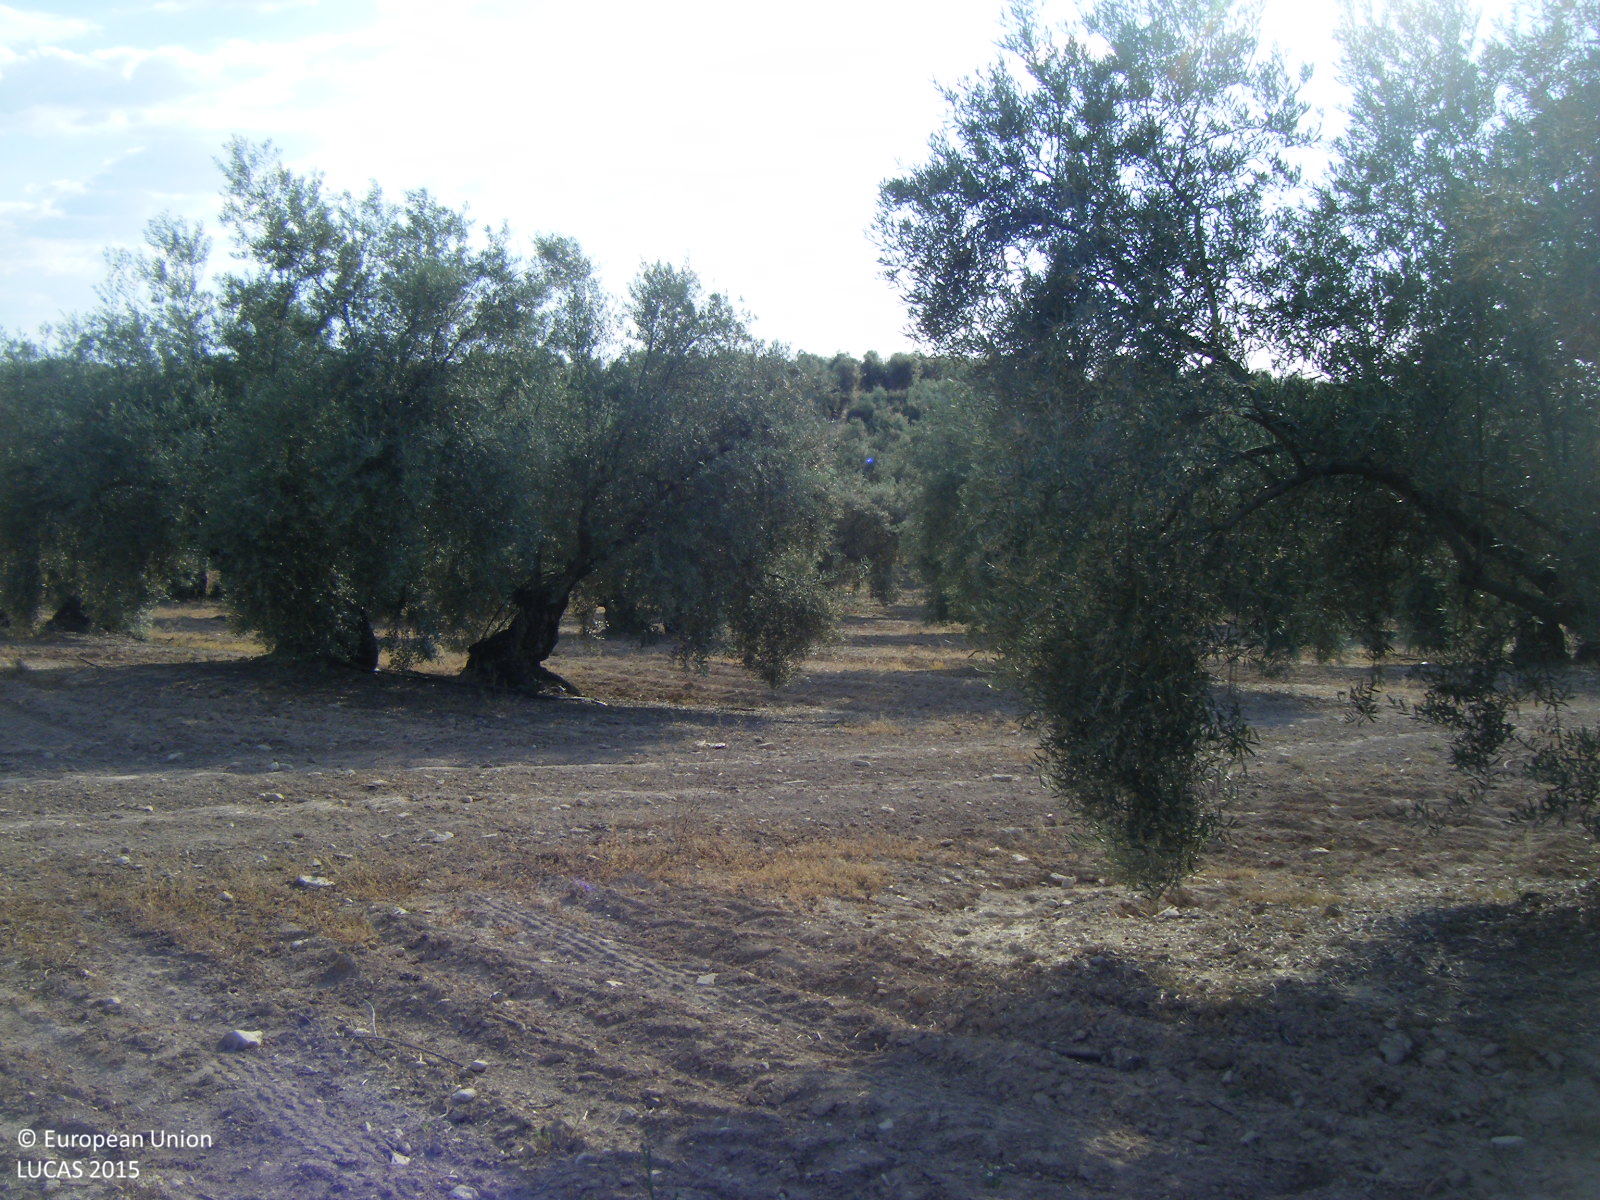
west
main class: Cropland
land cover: Olive groves
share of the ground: 10 - 25 %
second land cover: Other bare soil
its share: > 75 %
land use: Agriculture (excluding fallow land and kitchen gardens)
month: May
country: ES
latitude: 37.2424
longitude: -4.4626
